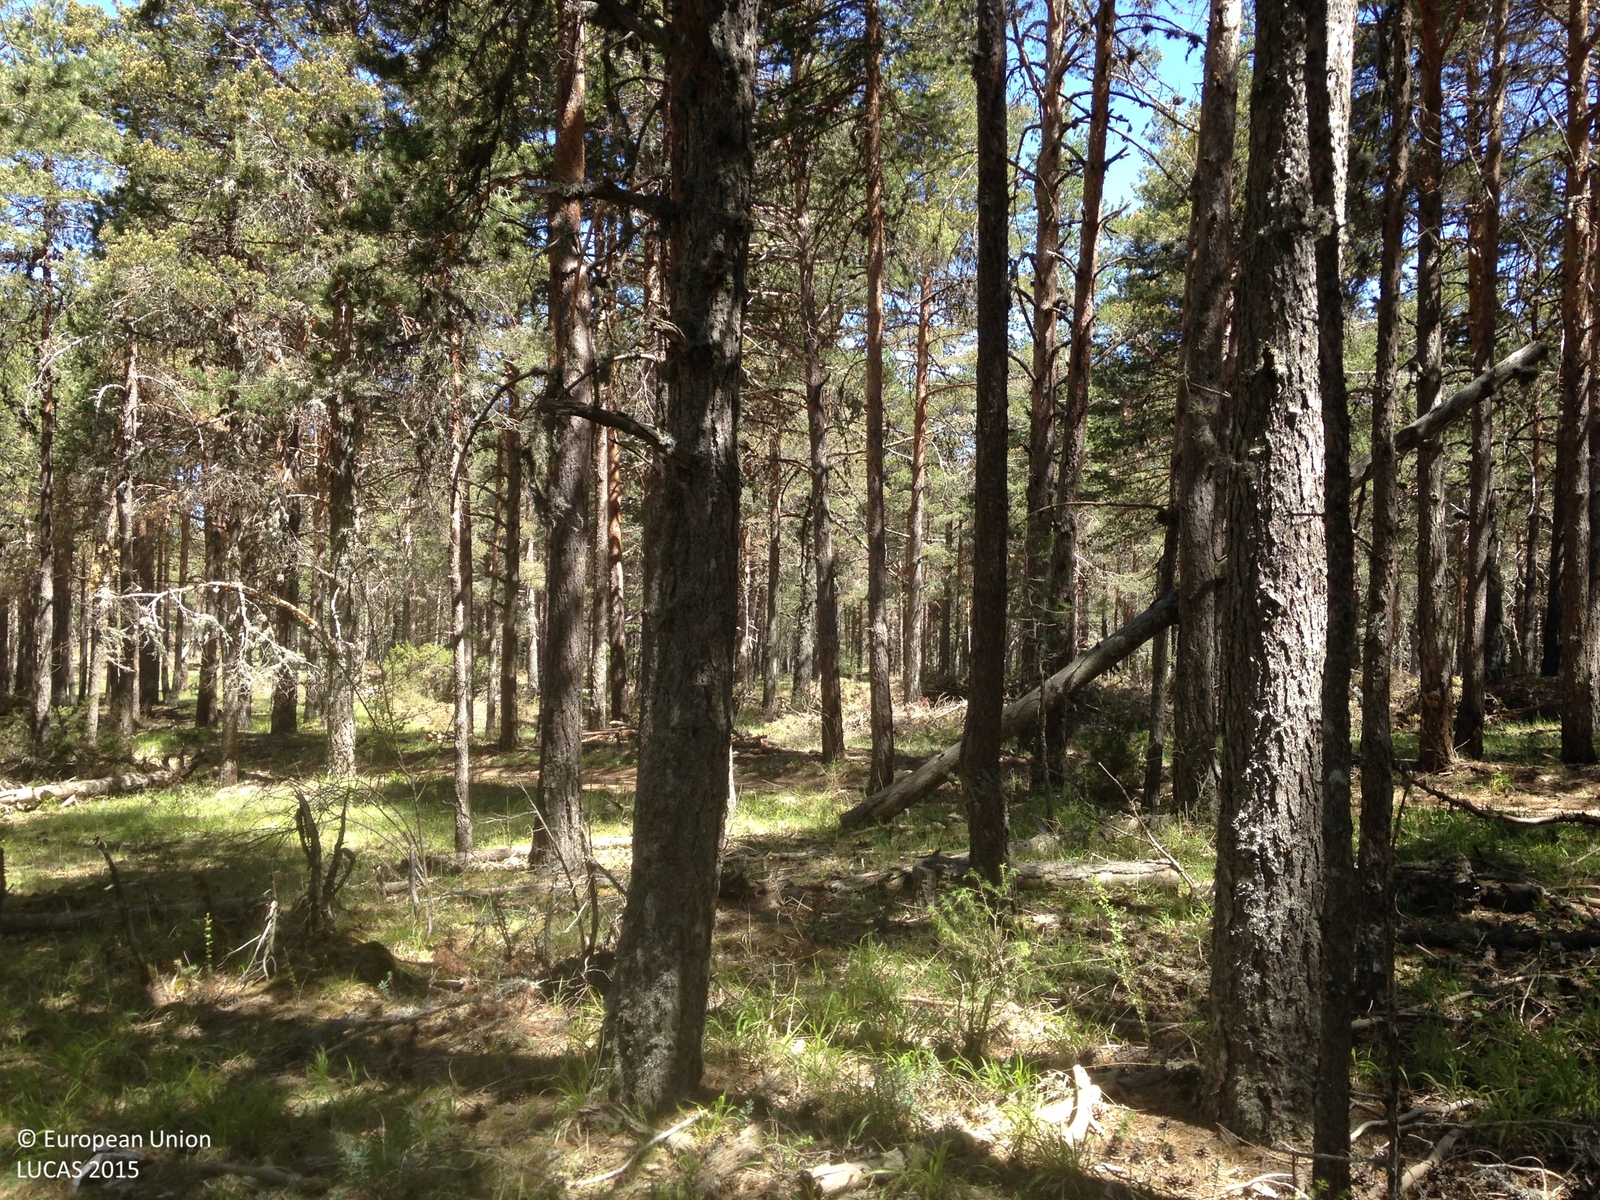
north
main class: Woodland
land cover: Pine dominated coniferous woodland
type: coniferous forest of the mediterranean region
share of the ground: 50 - 75 %
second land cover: Grassland without tree/shrub cover
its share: 50 - 75 %
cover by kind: coniferous forest trees 65 %, herbaceous plants 25 %, shrubs 10 %
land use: Forestry
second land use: Agriculture (excluding fallow land and kitchen gardens)
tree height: > 5 m
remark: Clear cut
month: May
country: ES
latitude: 40.5380
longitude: -1.9558
